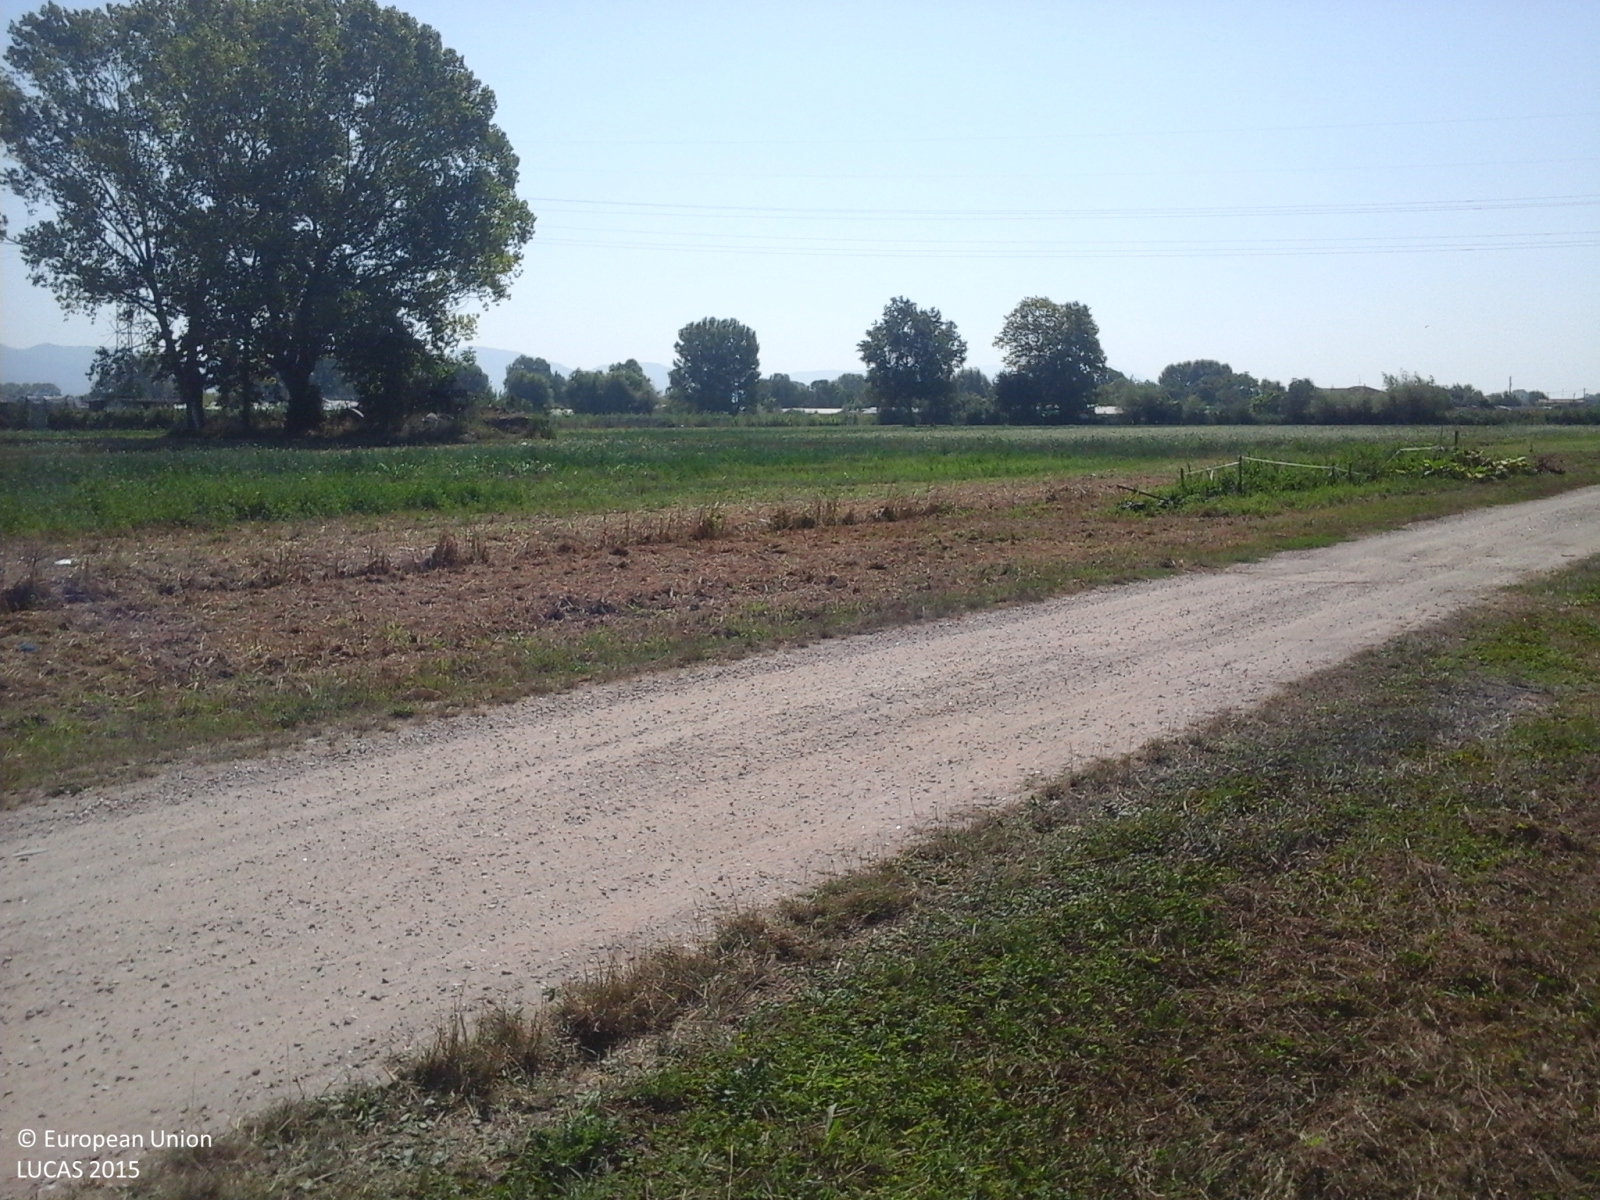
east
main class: Grassland
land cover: Spontaneously vegetated surfaces
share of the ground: > 75 %
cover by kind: herbaceous plants 100 %
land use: Fallow land
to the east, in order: Spontaneously vegetated surfaces; Tracks; Spontaneously vegetated surfaces; Managed hedges; Fences; Grassland without tree/shrub cover; Fences; Tracks; Spontaneously vegetated surfaces; Electric lines; Spontaneously vegetated surfaces; Ditches and canals; Shrubland without tree cover
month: August
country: IT
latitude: 43.8812
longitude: 10.2607
